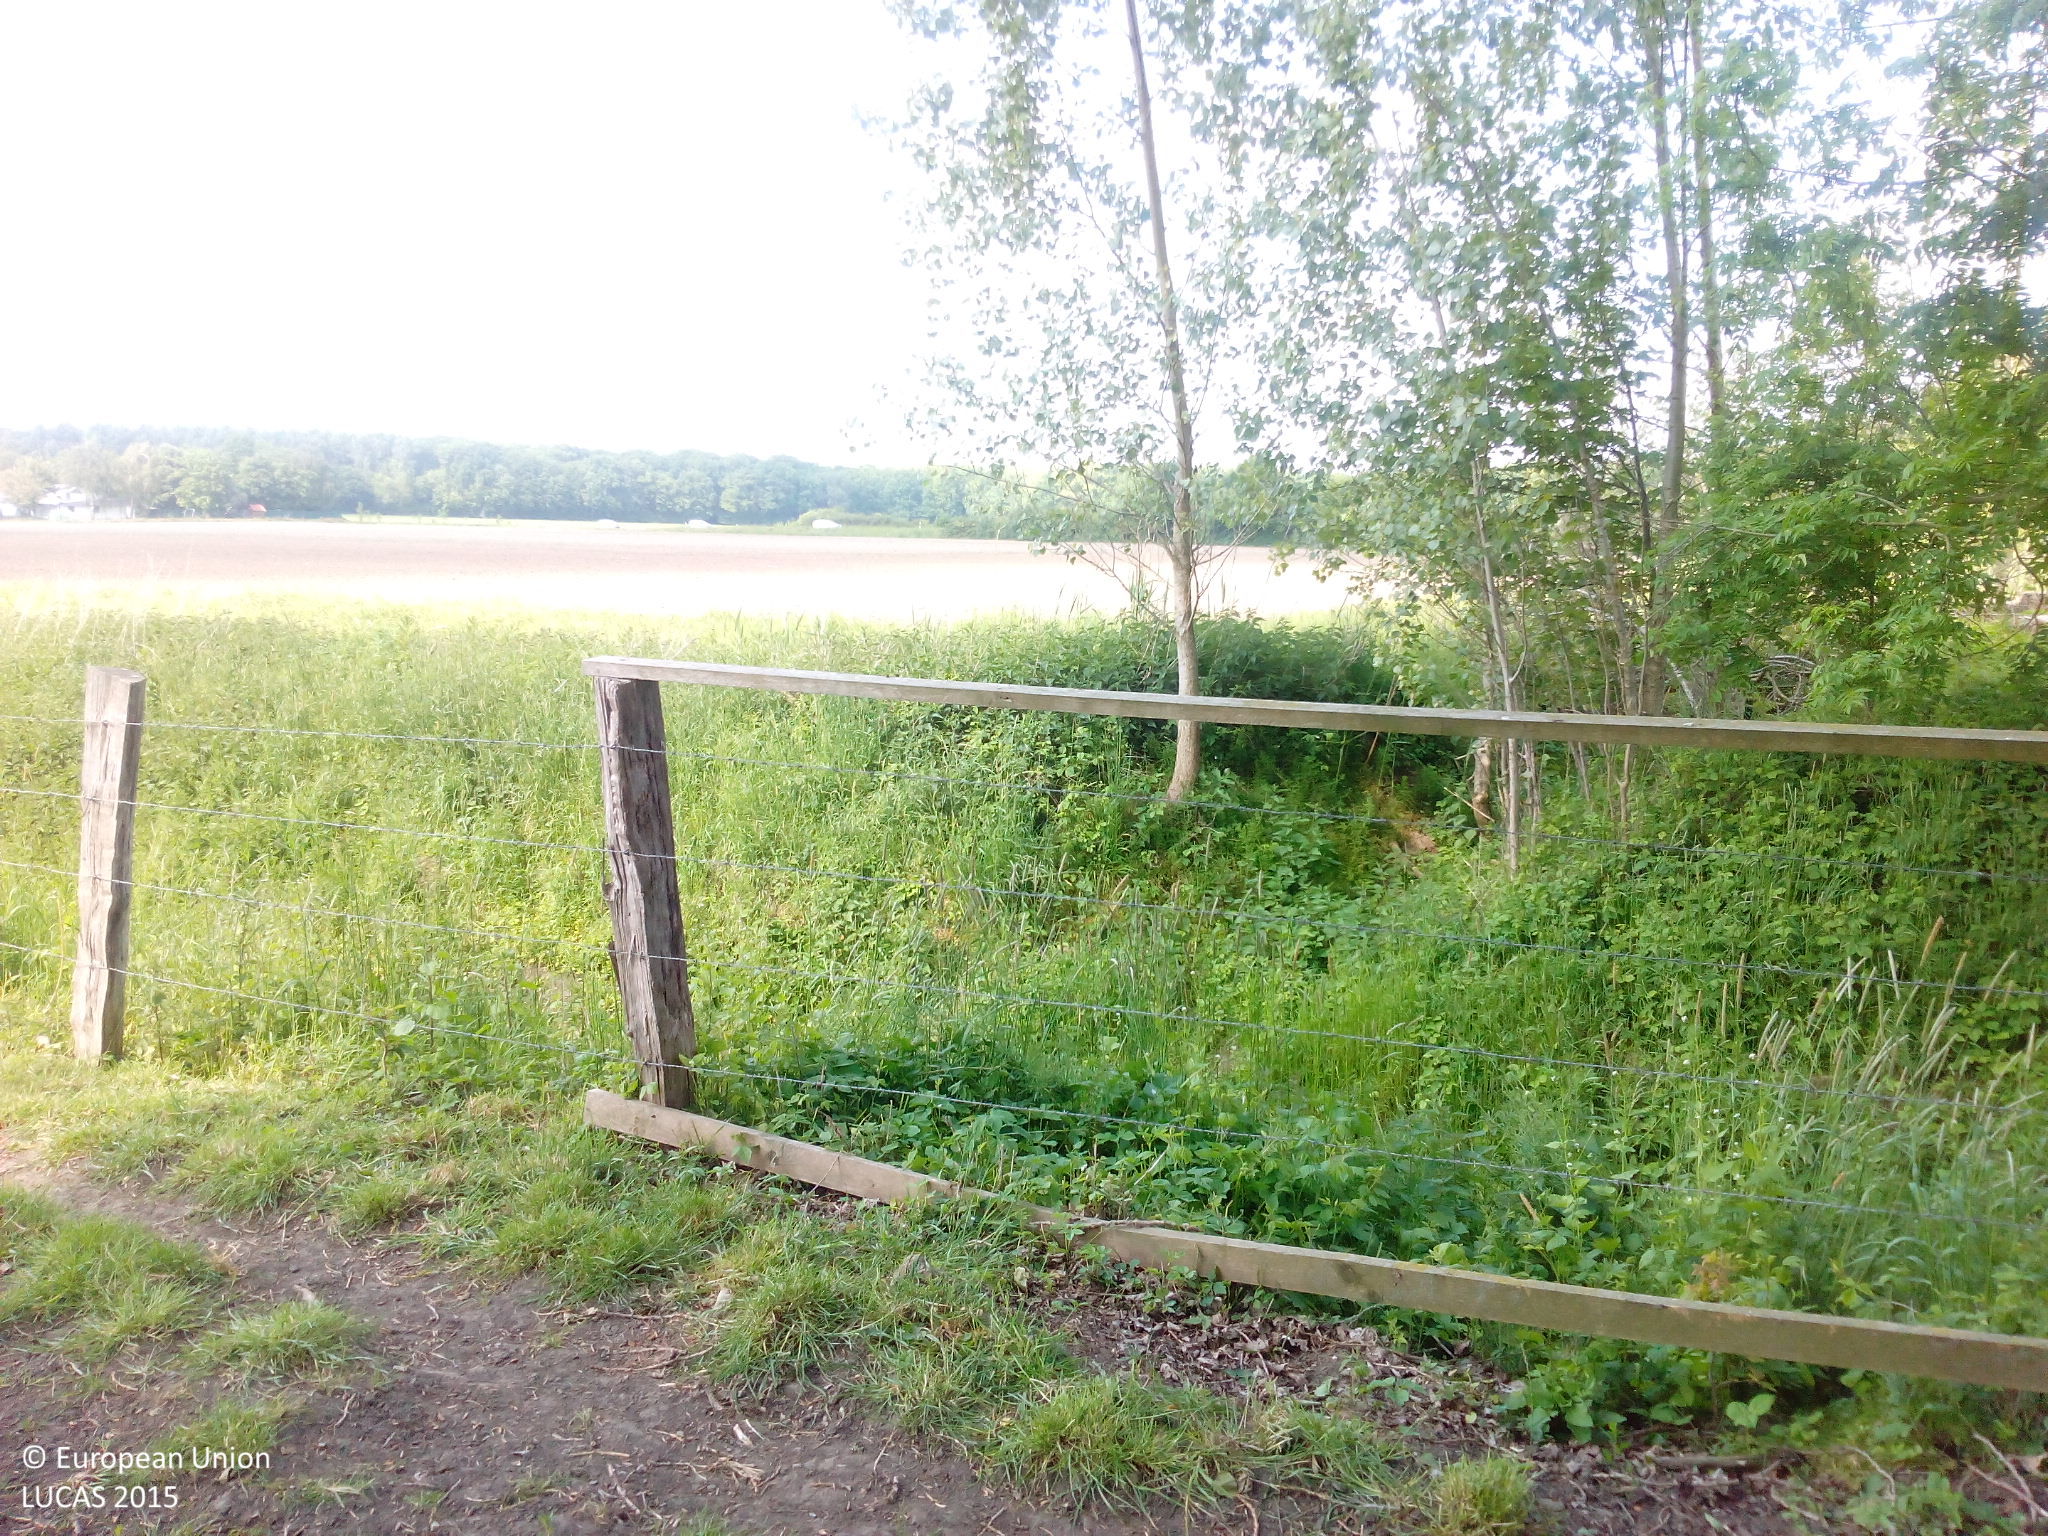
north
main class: Grassland
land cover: Grassland without tree/shrub cover
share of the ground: > 75 %
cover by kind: herbaceous plants 100 %
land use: Agriculture (excluding fallow land and kitchen gardens)
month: May
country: DE
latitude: 51.6947
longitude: 7.9605
